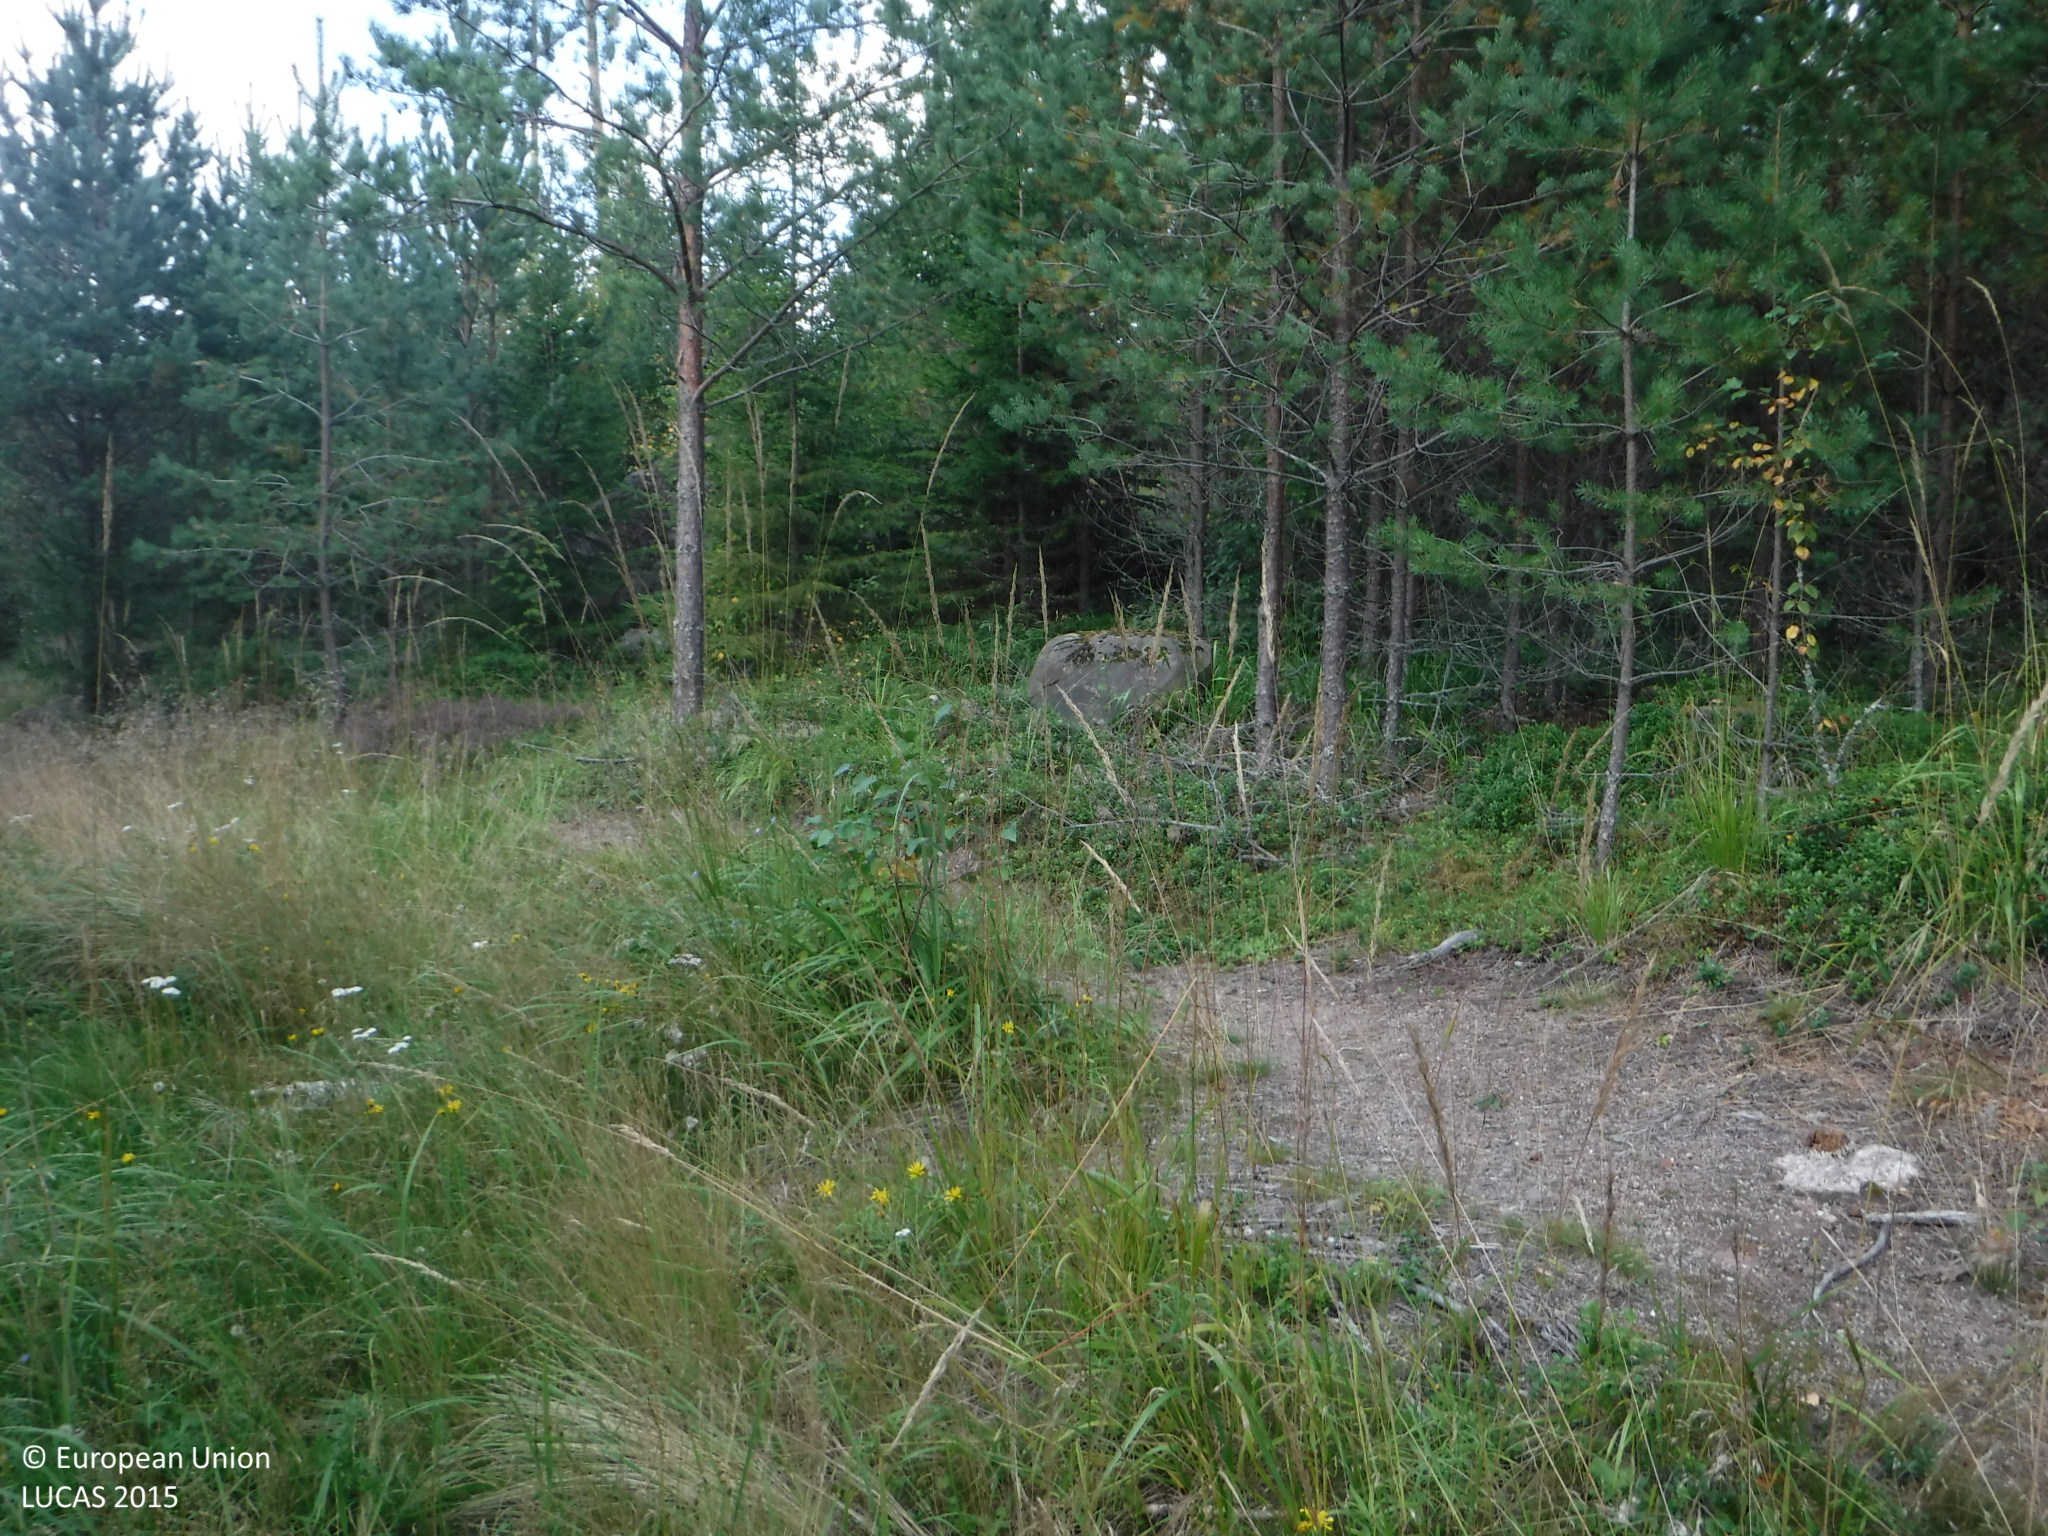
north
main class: Woodland
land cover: Pine dominated coniferous woodland
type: boreal forest
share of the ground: 50 - 75 %
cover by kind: coniferous forest trees 50 %, shrubs 35 %, lichens and mosses 10 %, herbaceous plants 5 %
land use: Forestry
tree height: > 5 m
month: August
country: FI
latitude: 61.2537
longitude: 21.7797
